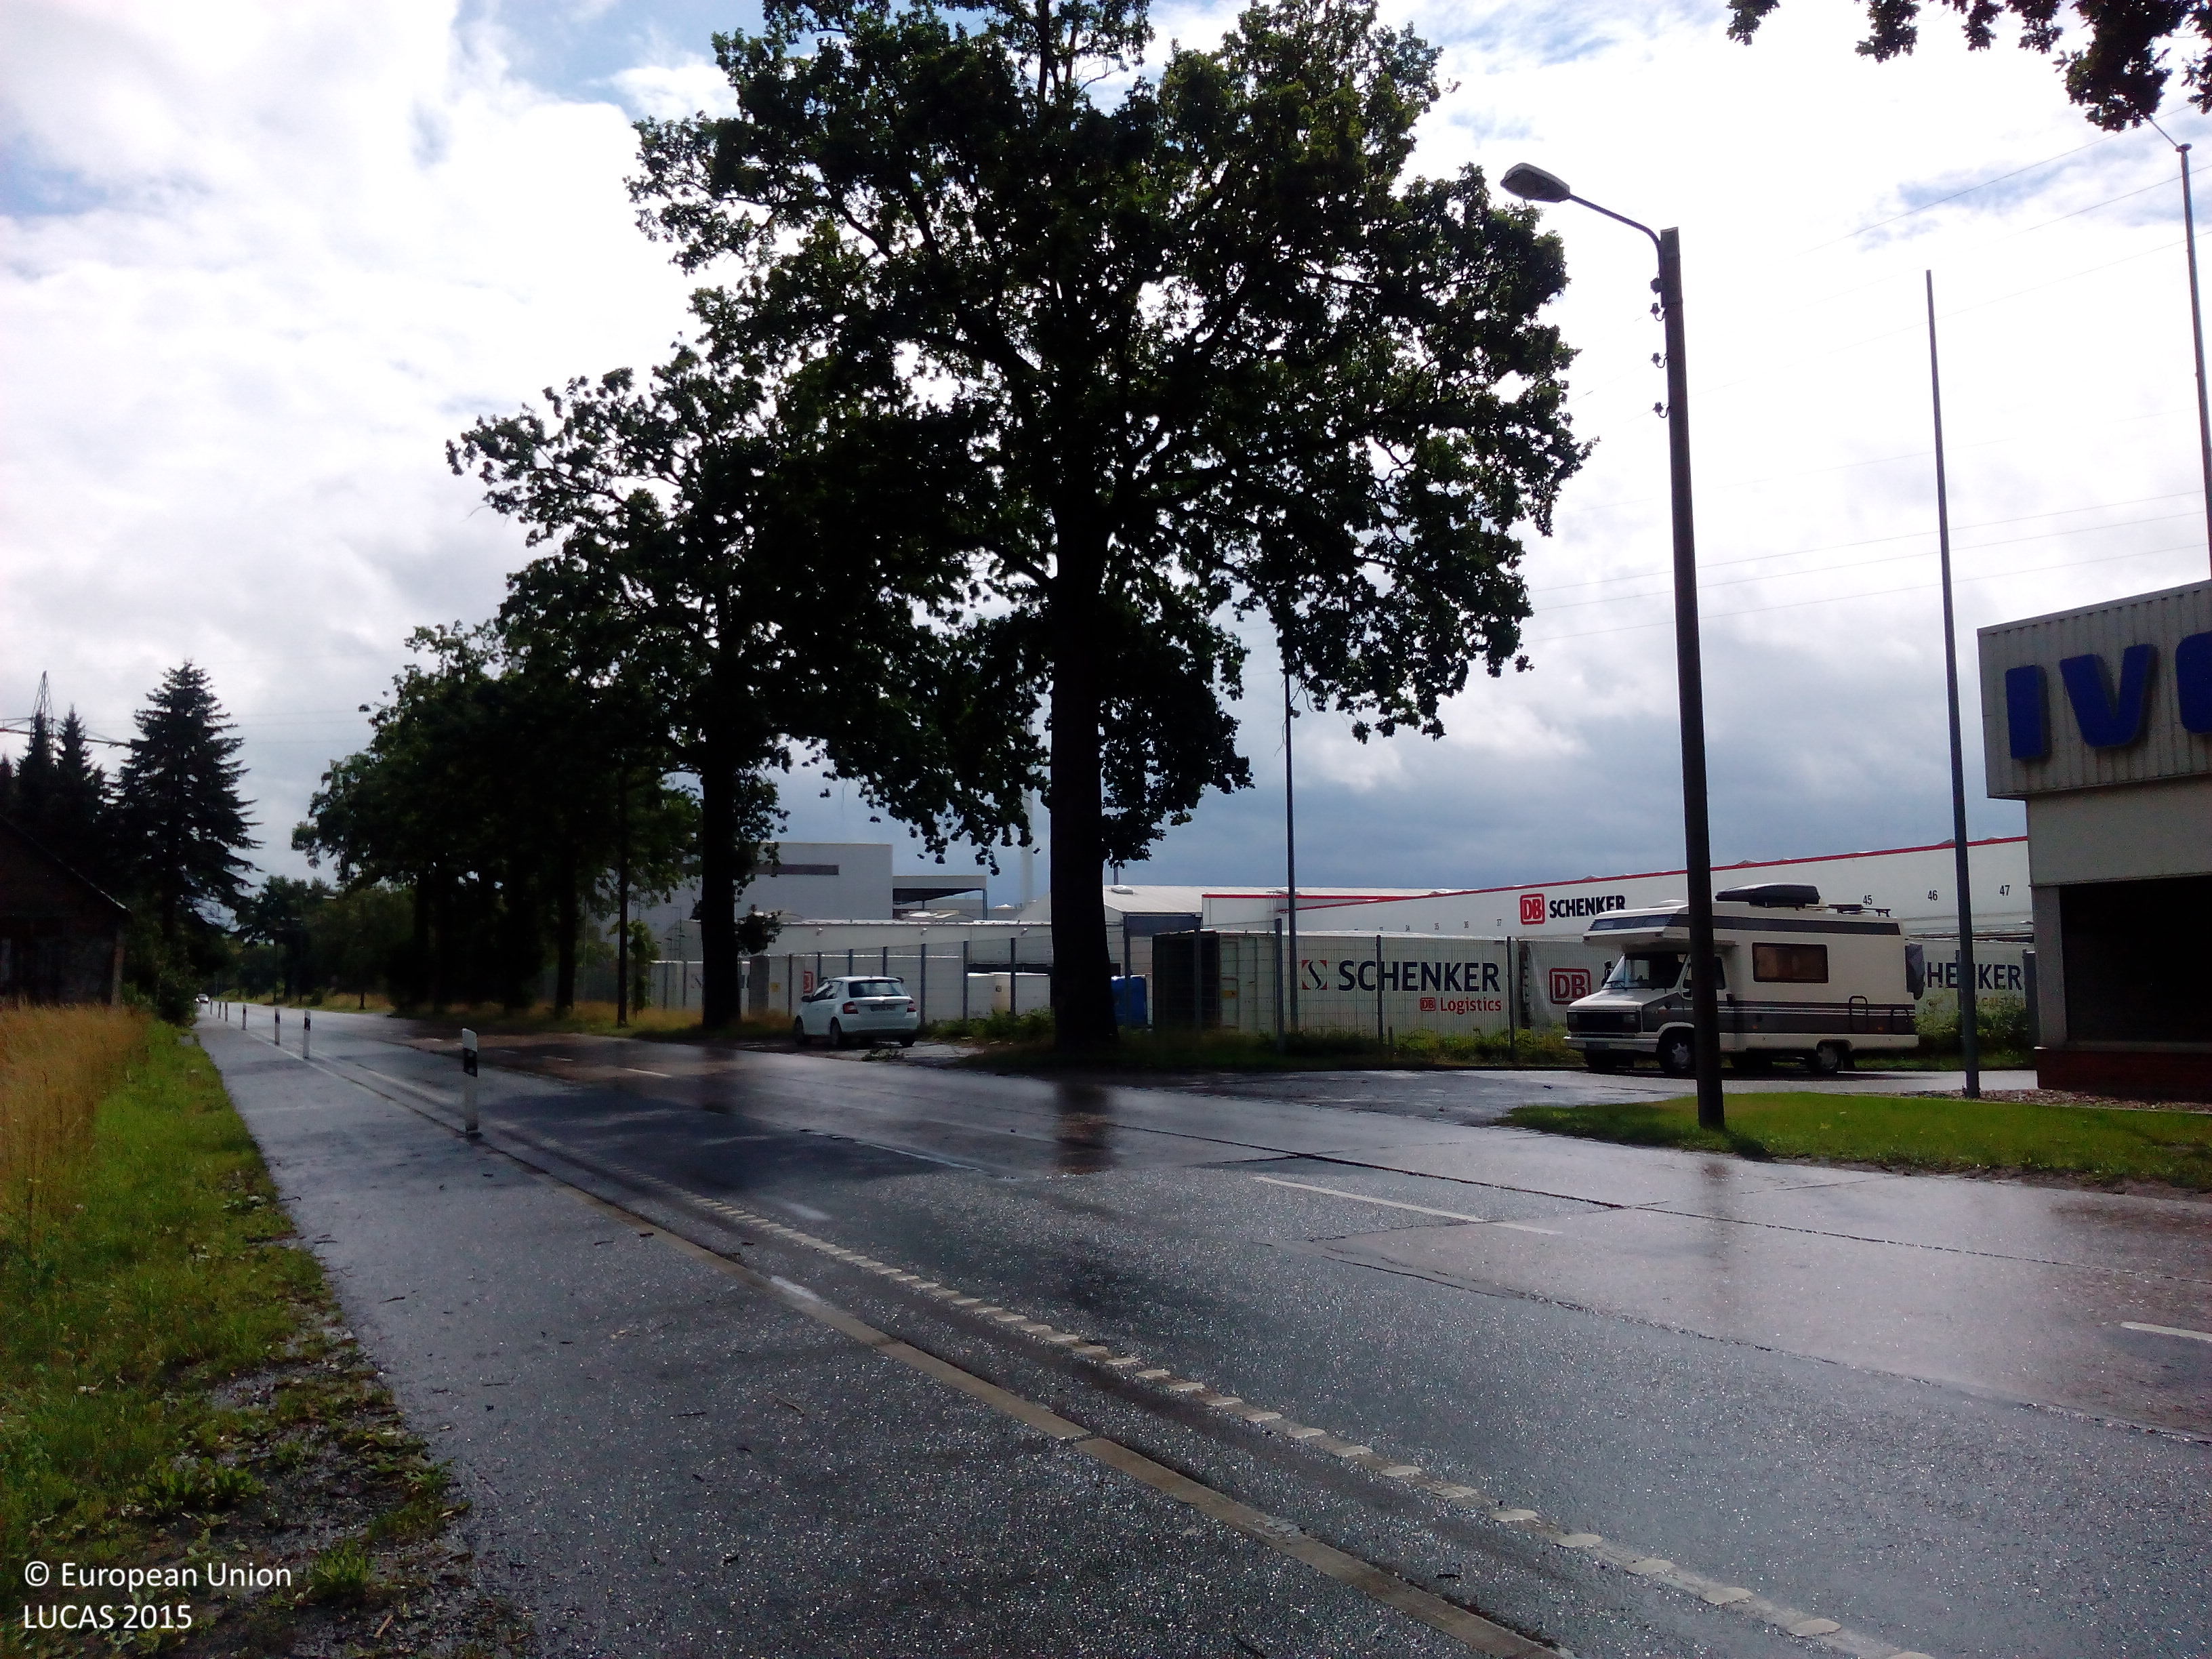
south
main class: Grassland
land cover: Grassland without tree/shrub cover
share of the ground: > 75 %
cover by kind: herbaceous plants 100 %
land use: Agriculture (excluding fallow land and kitchen gardens)
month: July
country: DE
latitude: 52.3070
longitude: 8.0205
